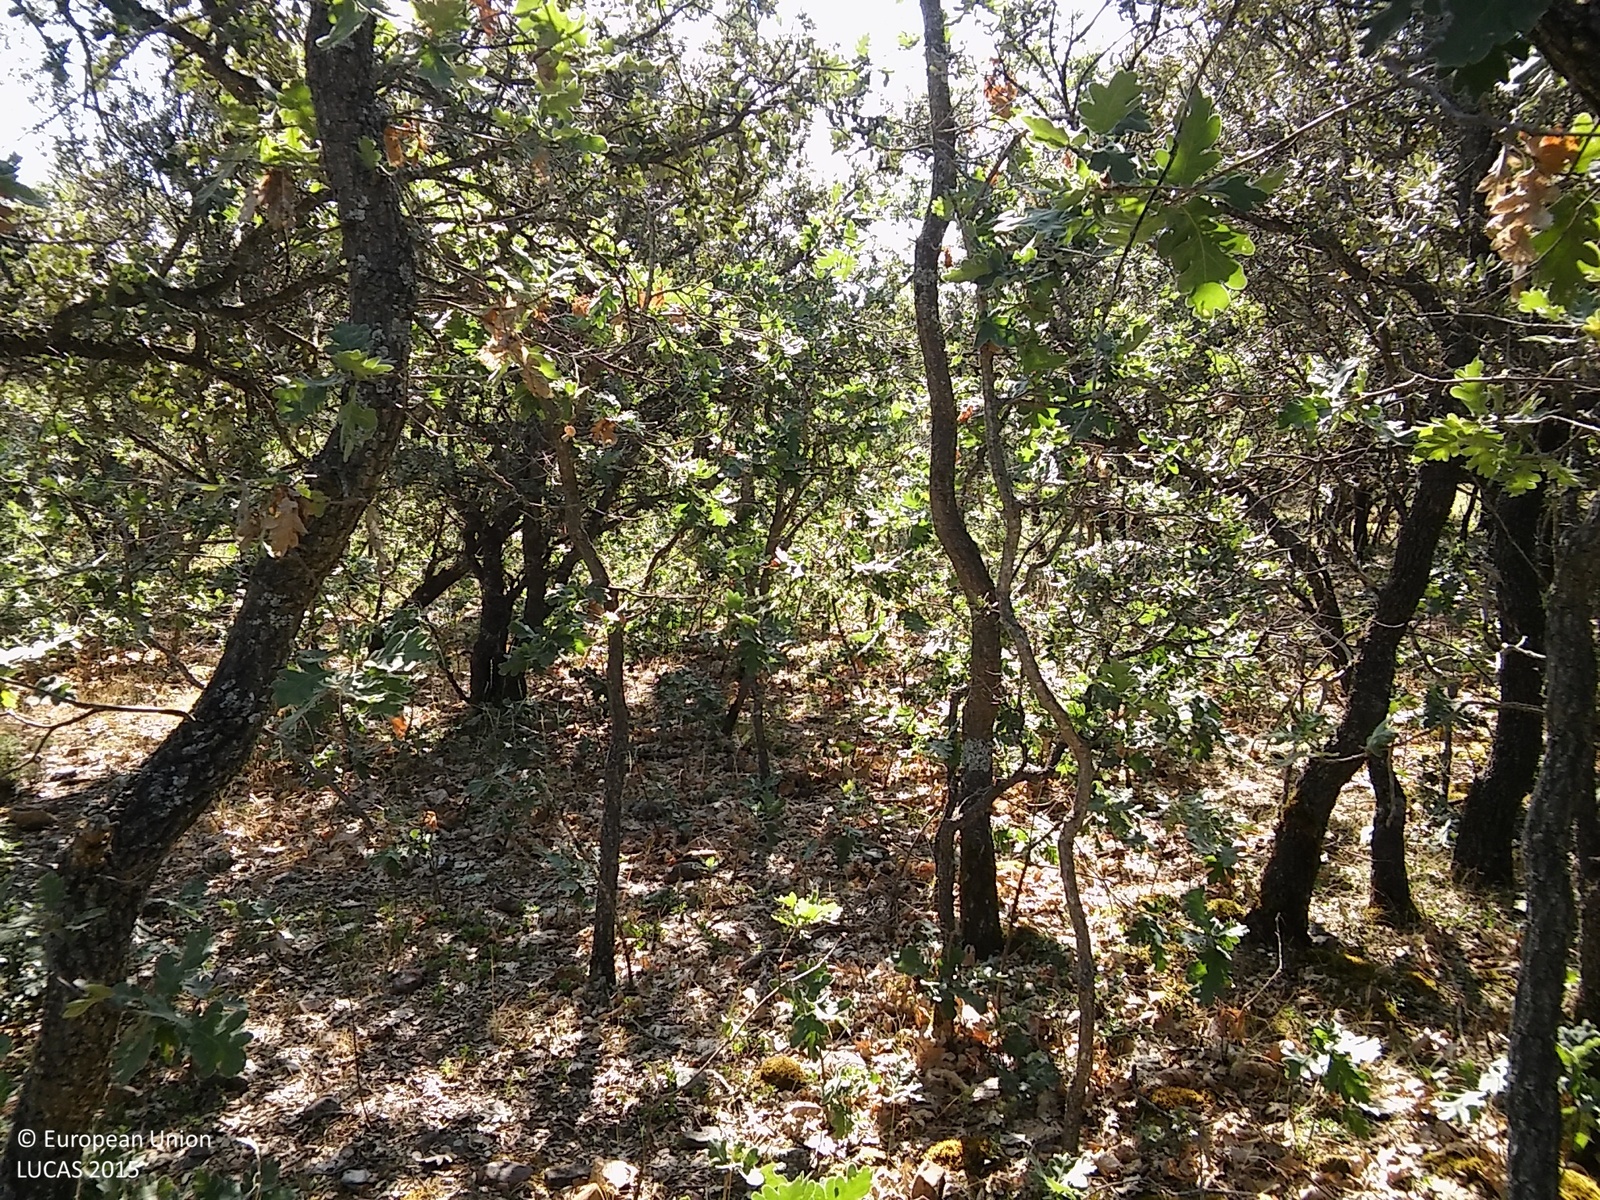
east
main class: Woodland
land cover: Broadleaved woodland
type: thermophilous deciduous forest
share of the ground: 50 - 75 %
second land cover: Shrubland without tree cover
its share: 25 - 50 %
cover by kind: broadleaved forest trees 50 %, shrubs 30 %, herbaceous plants 10 %, lichens and mosses 10 %
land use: Forestry
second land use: Agriculture (excluding fallow land and kitchen gardens)
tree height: > 5 m
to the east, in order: Broadleaved woodland; Shrubland without tree cover; Tracks; Broadleaved woodland
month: July
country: ES
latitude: 41.3444
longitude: -3.4909
